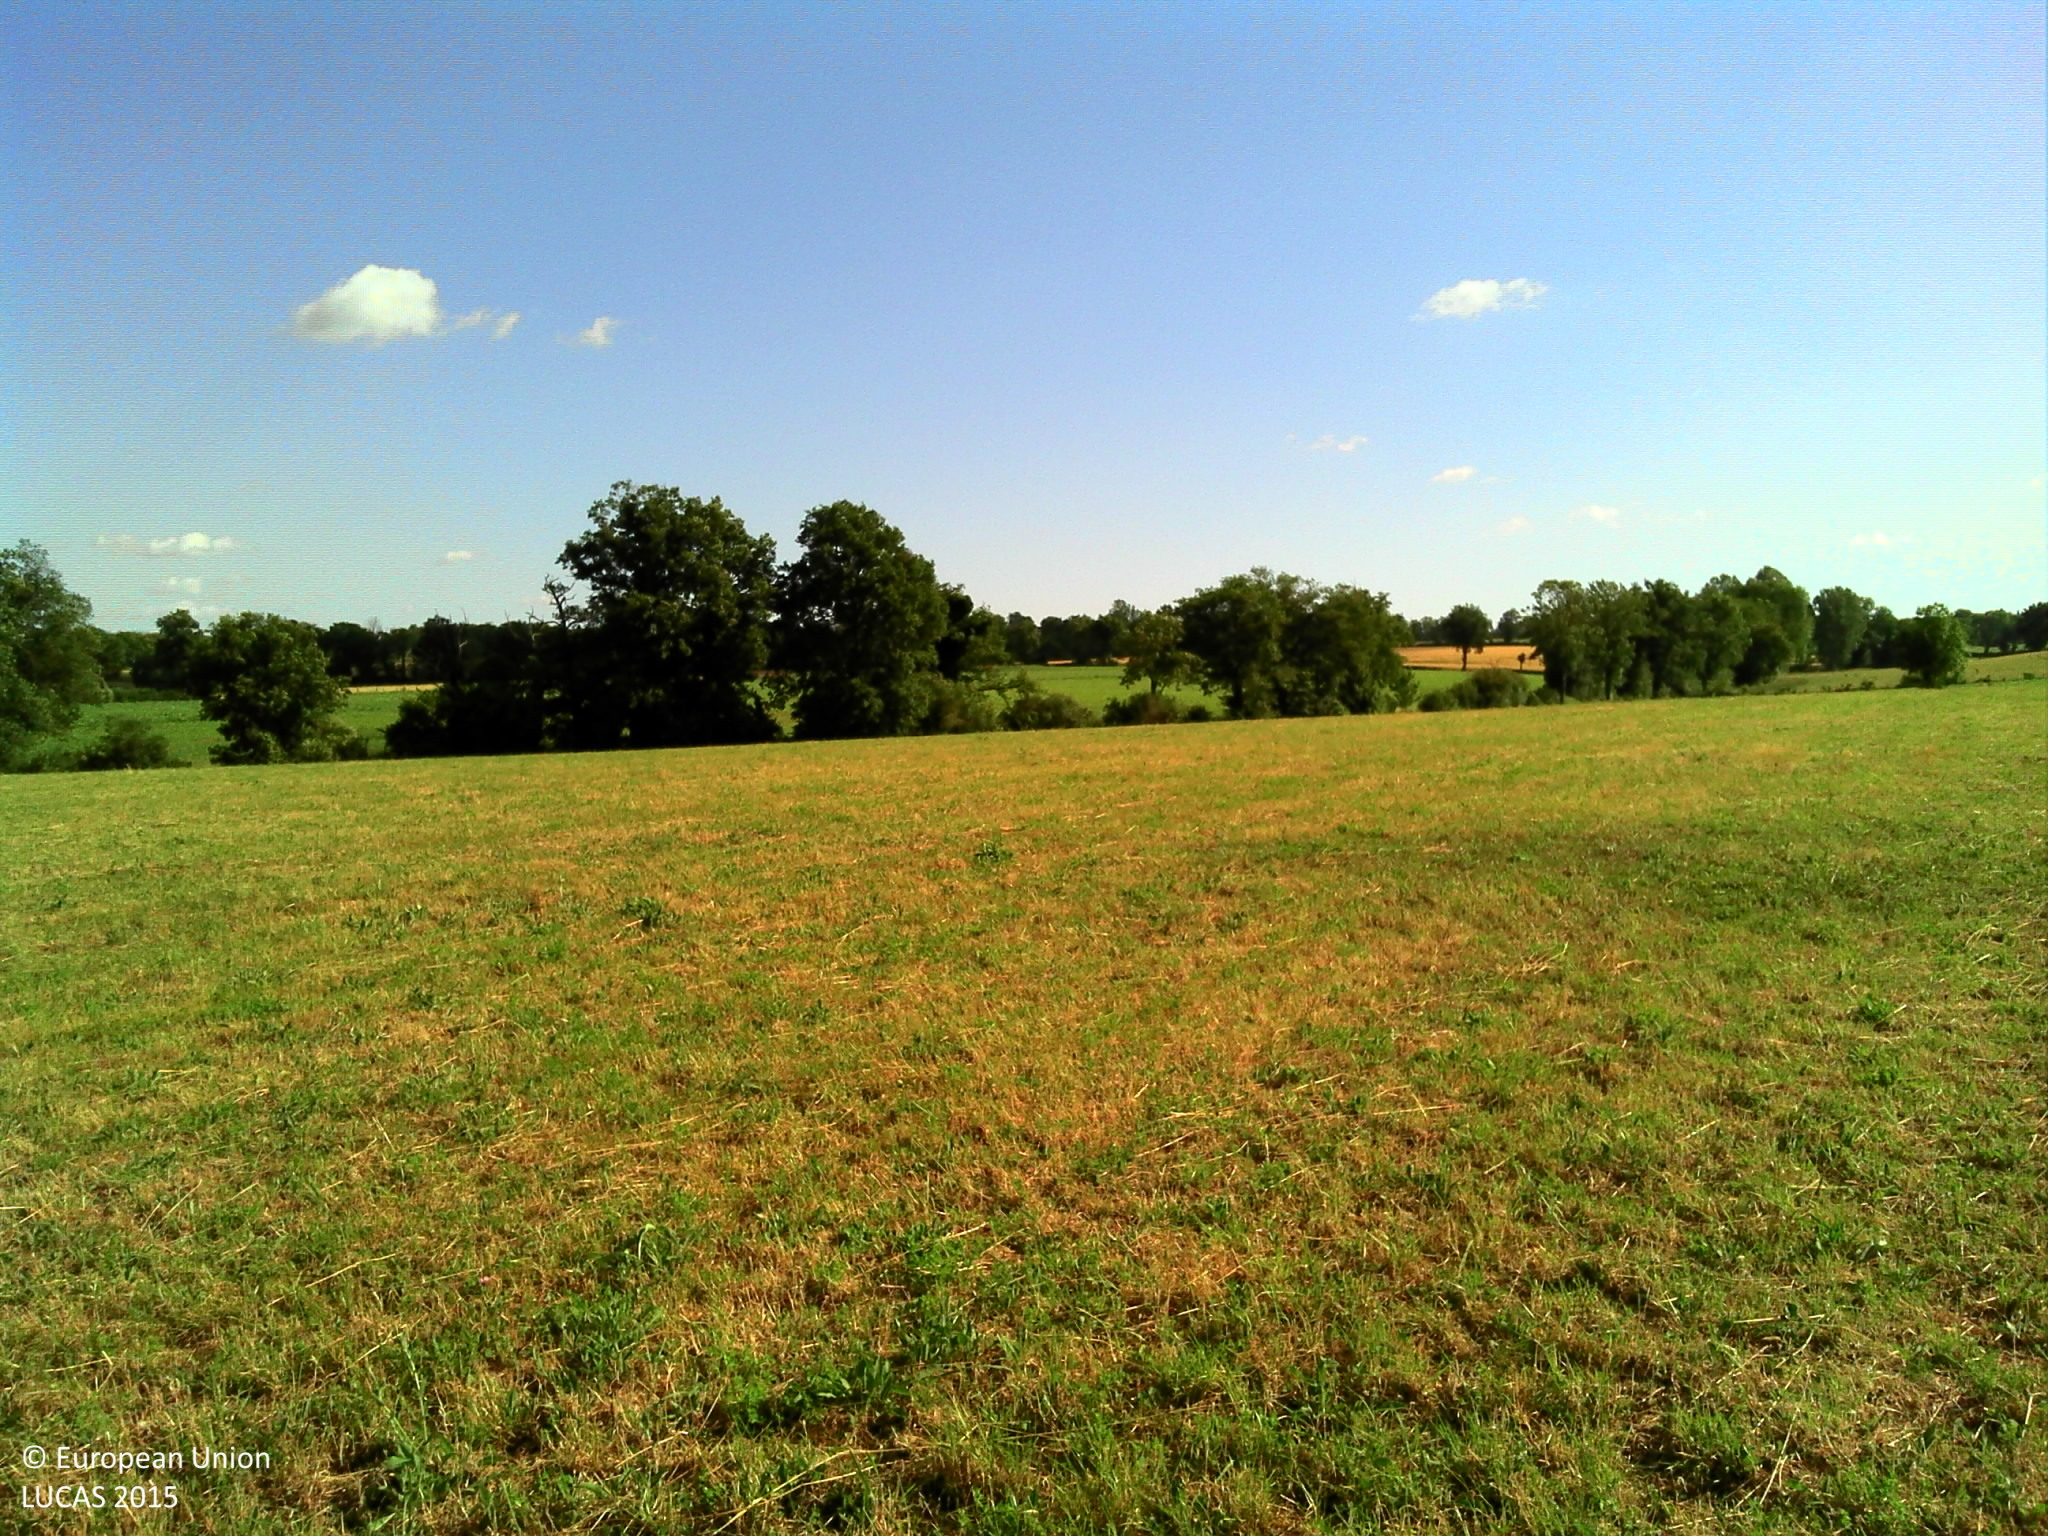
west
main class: Grassland
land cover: Grassland without tree/shrub cover
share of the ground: > 75 %
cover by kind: herbaceous plants 100 %
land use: Agriculture (excluding fallow land and kitchen gardens)
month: June
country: FR
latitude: 44.3676
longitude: 2.4864
